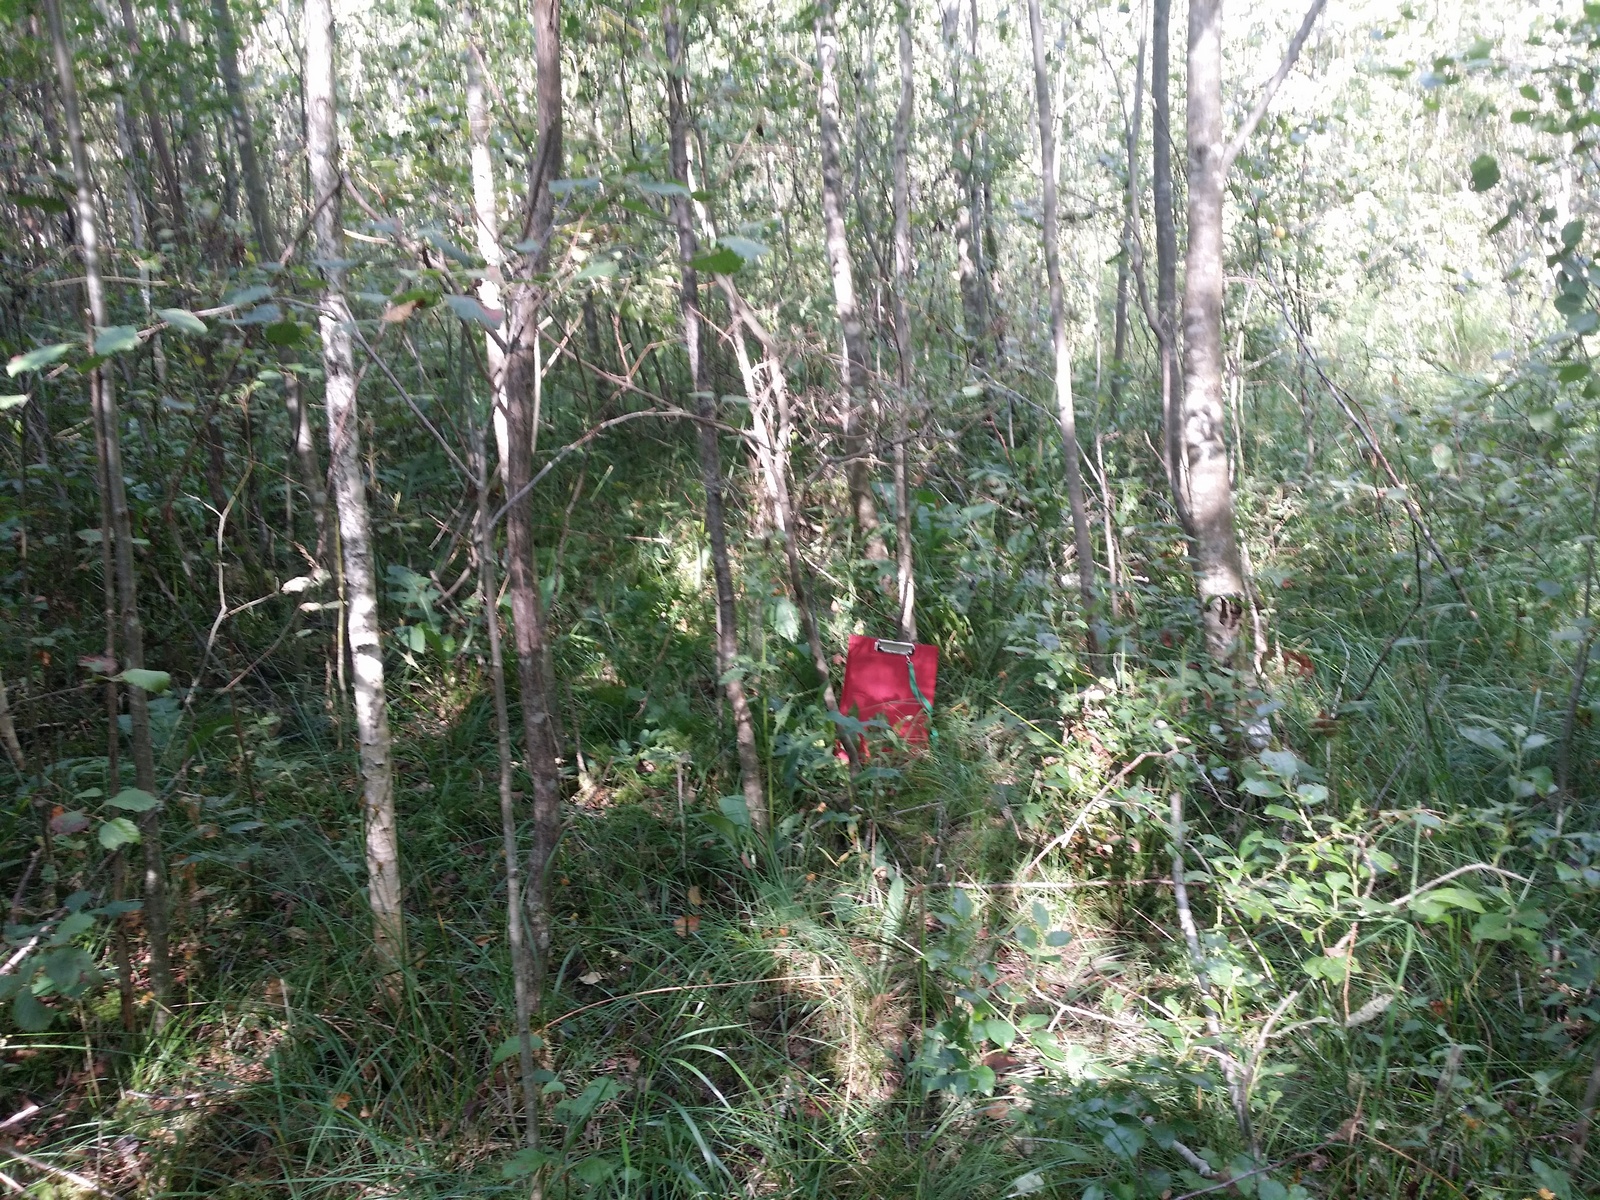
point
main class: Woodland
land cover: Broadleaved woodland
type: non-riverine alder, birch or aspen forest
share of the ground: > 75 %
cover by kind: broadleaved forest trees 85 %, herbaceous plants 15 %
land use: Semi-natural and natural areas not in use
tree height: < 5 m
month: August
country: LV
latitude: 57.5065
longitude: 26.8947
